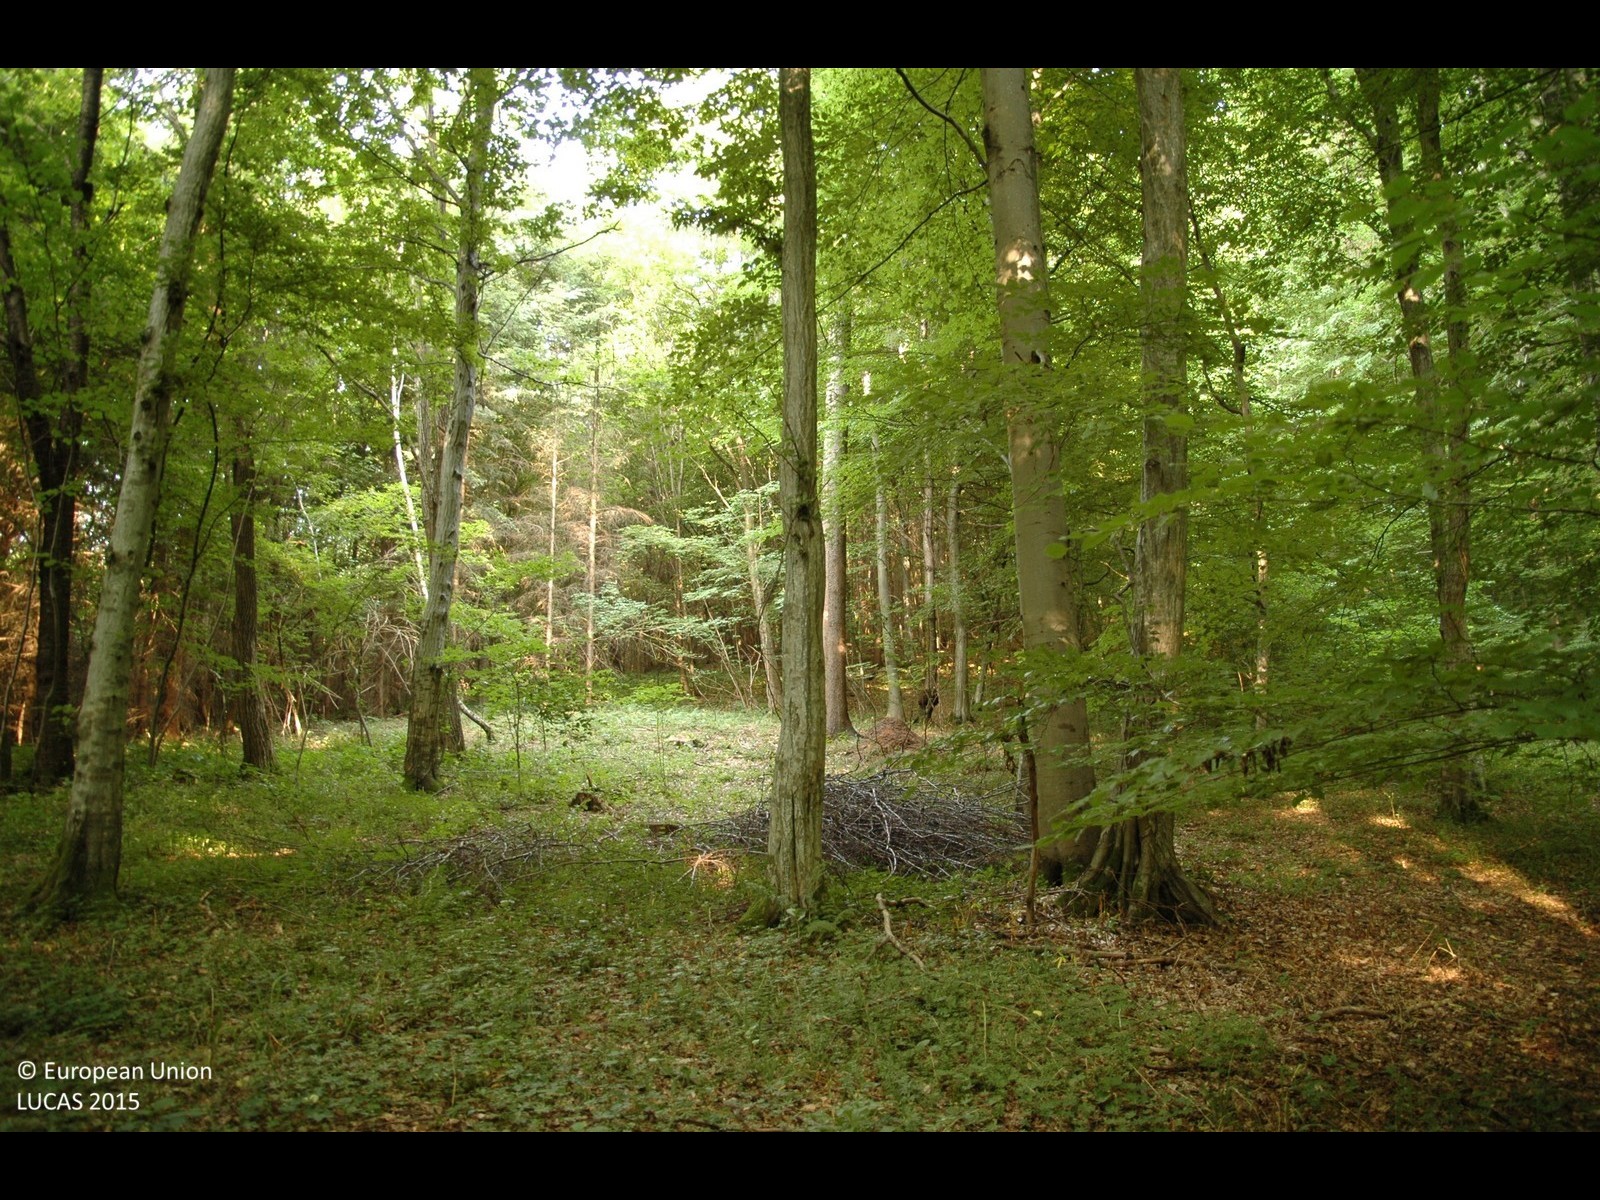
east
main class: Woodland
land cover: Broadleaved woodland
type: mesophytic deciduous forest
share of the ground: > 75 %
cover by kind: broadleaved forest trees 100 %
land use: Forestry
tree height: > 5 m
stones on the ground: < 10 %
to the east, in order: Broadleaved woodland; Spruce dominated coniferous woodland; Broadleaved woodland; Grass margins; Paved roads, cycling and walking lanes; Managed hedges; Artificial constructions in urban areas; Apple fruit
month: June
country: HR
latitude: 46.4536
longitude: 16.3148
